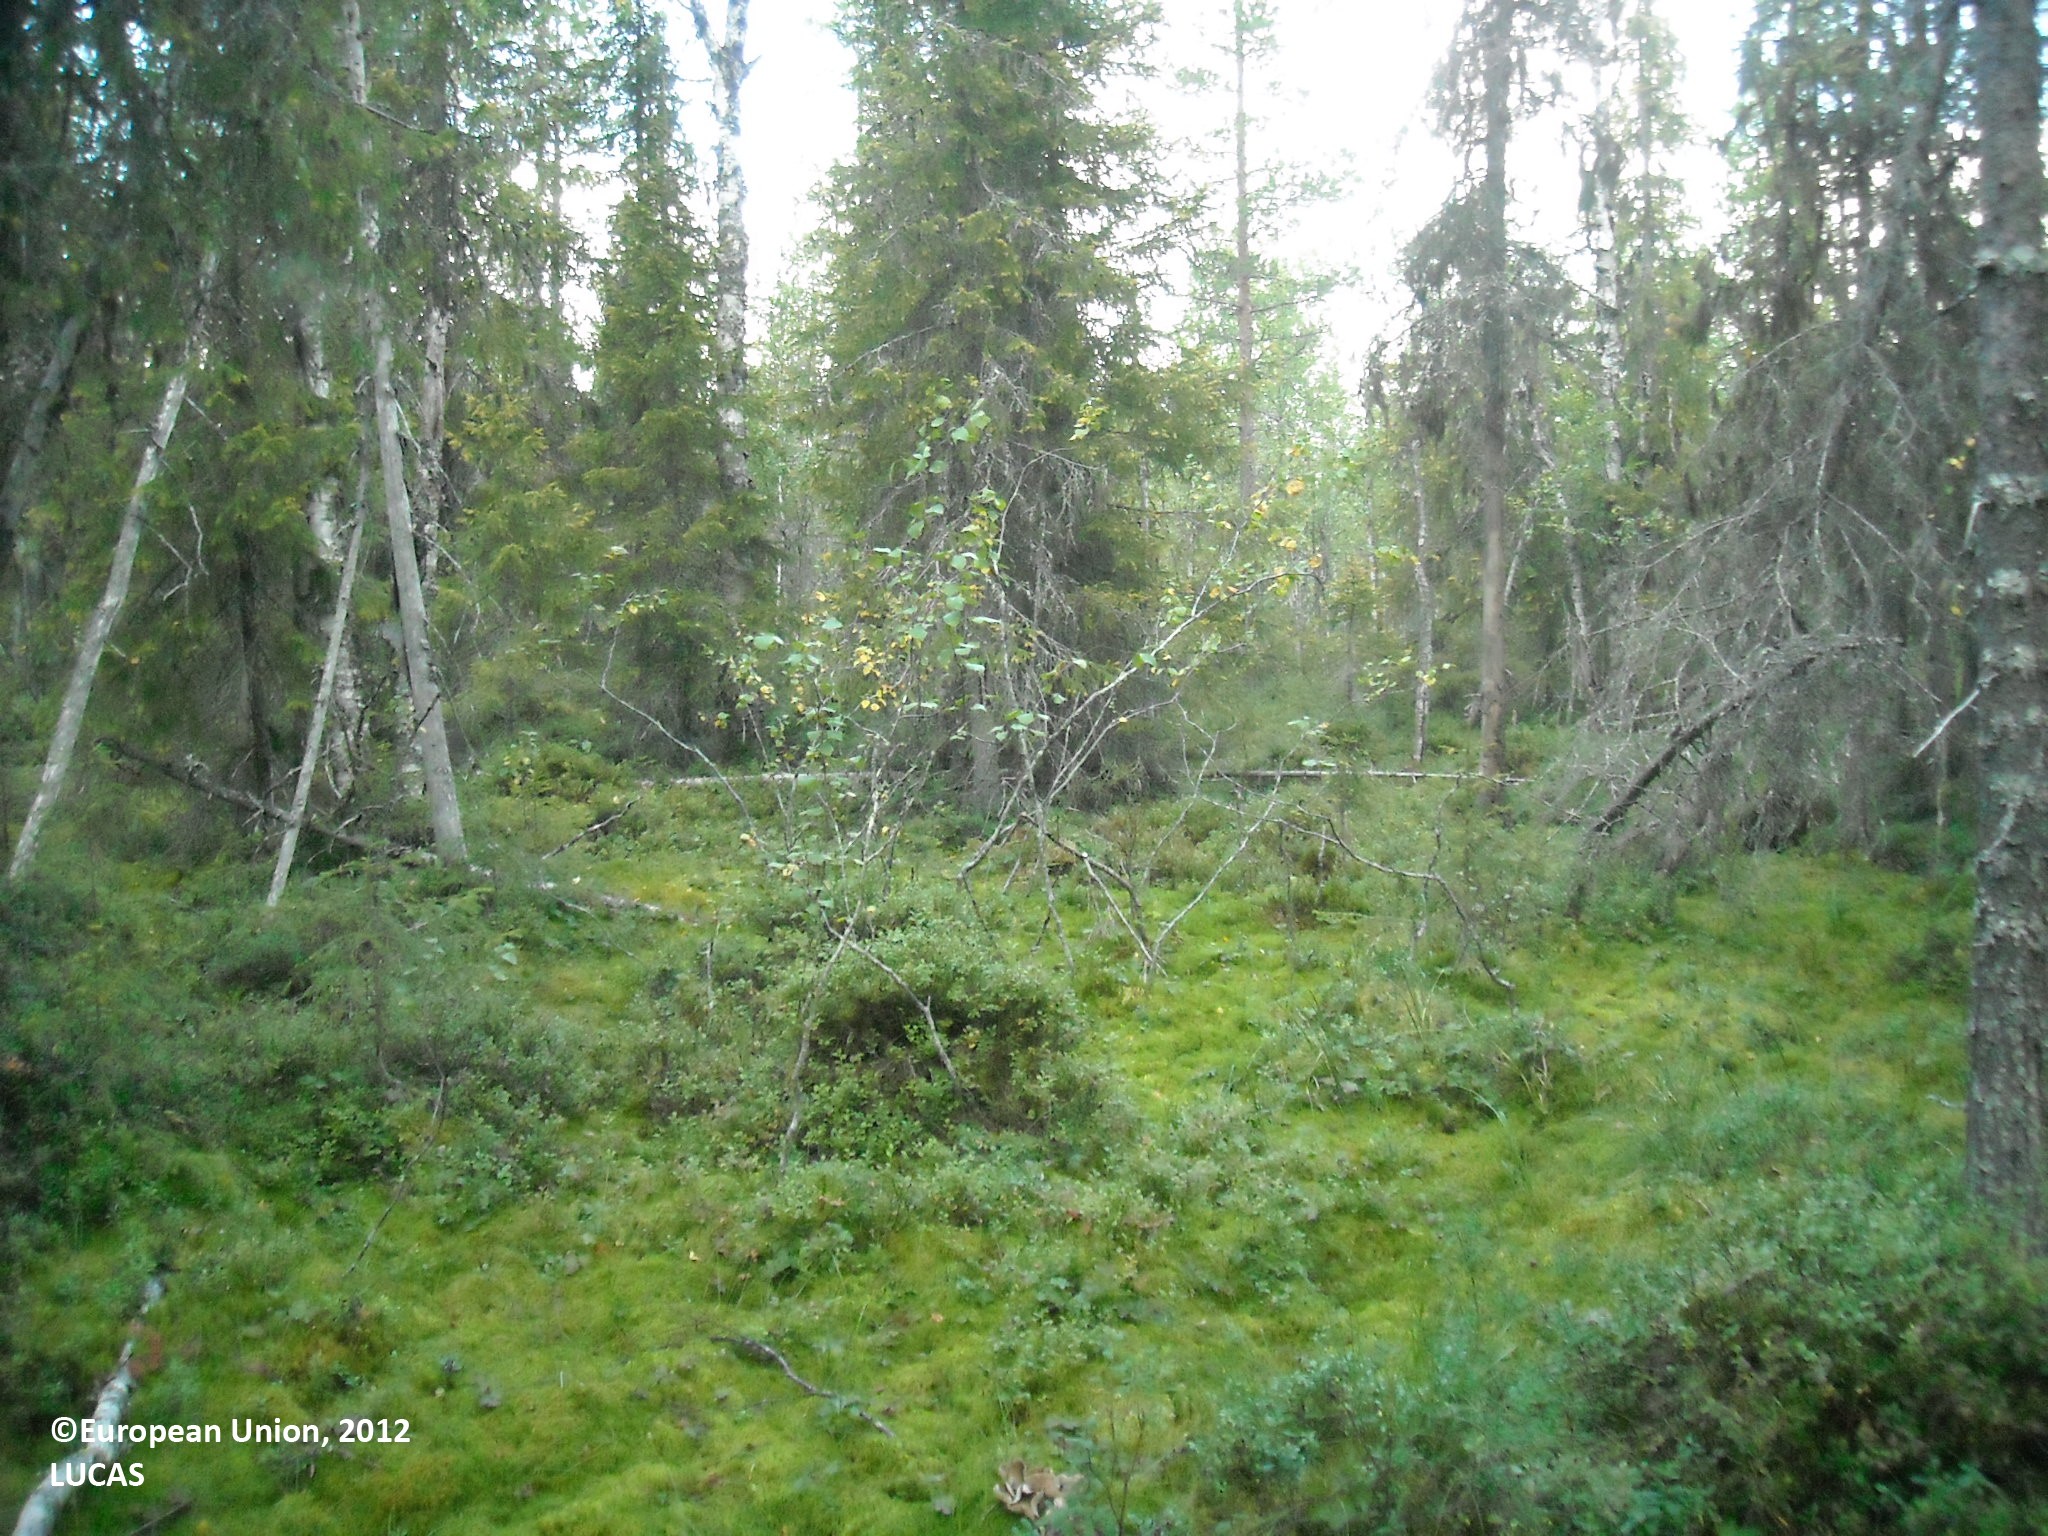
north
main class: Woodland
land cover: Spruce dominated mixed woodland
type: mire and swamp forests
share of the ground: > 75 %
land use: Forestry
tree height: > 5 m
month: August
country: FI
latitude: 65.4345
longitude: 27.7502
